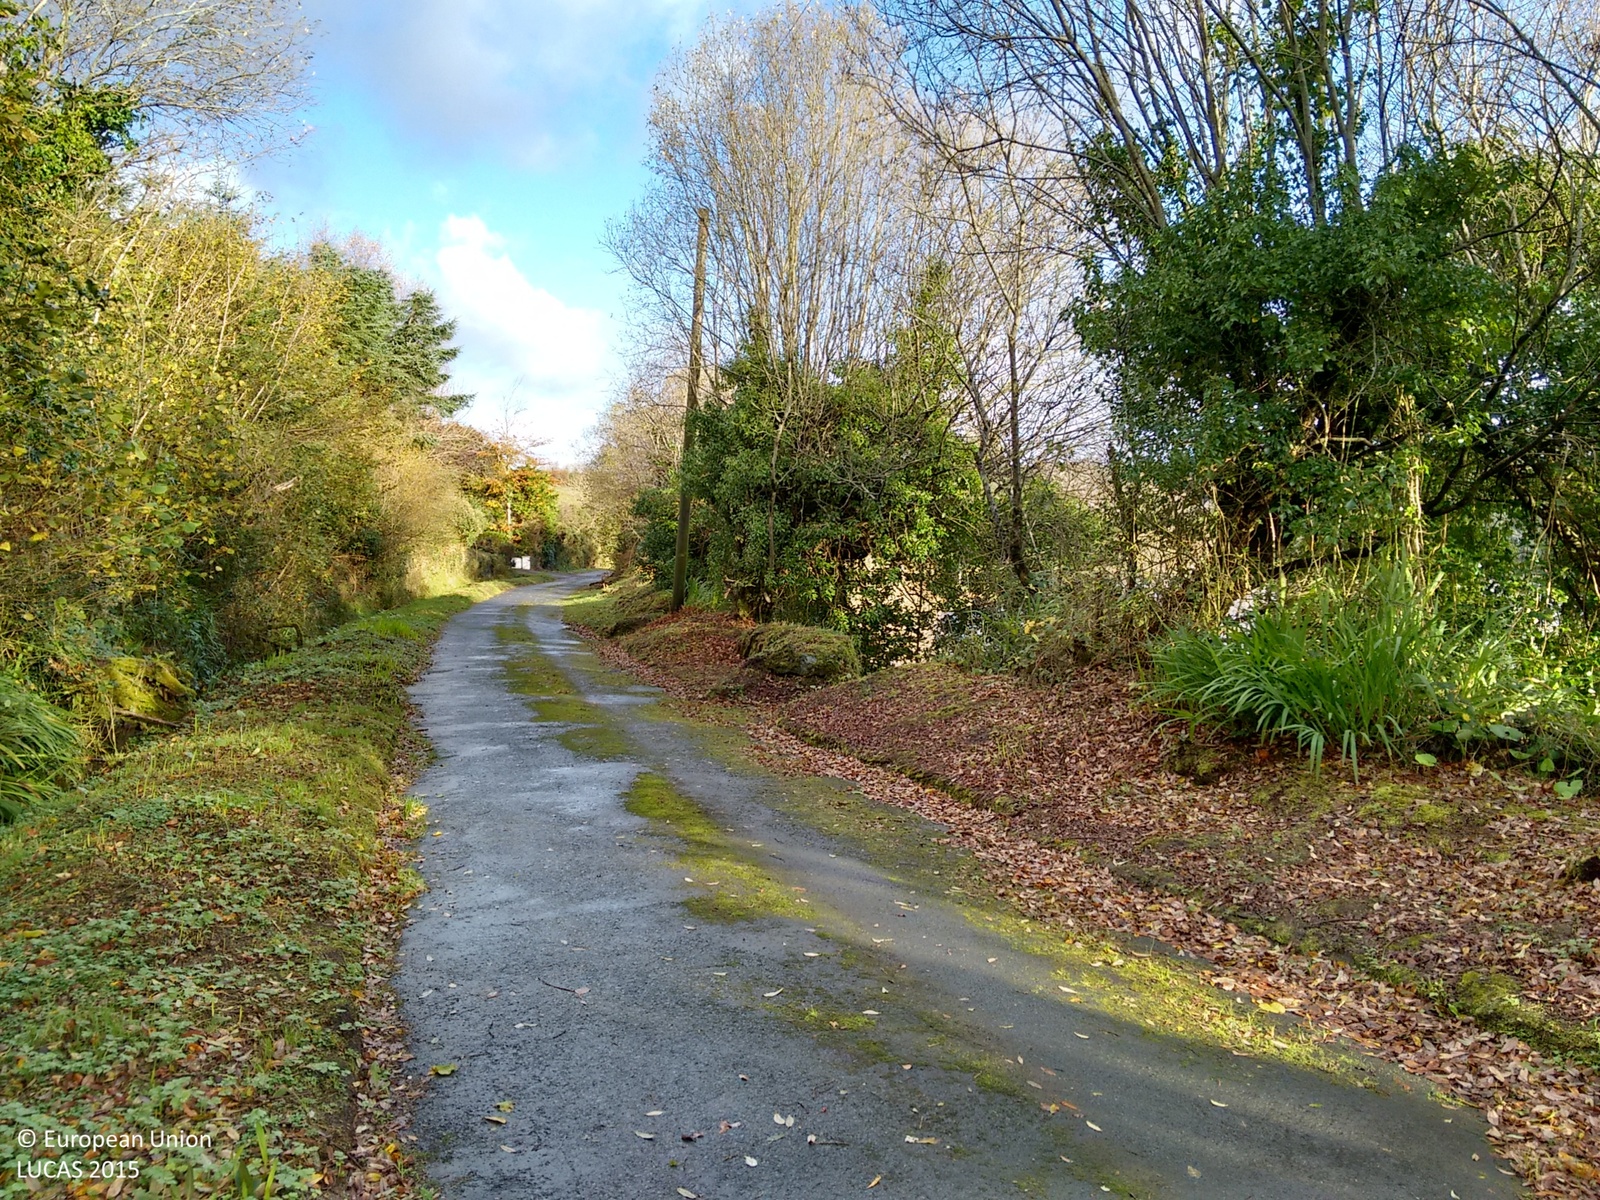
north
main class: Woodland
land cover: Broadleaved woodland
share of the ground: > 75 %
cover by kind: broadleaved forest trees 80 %, herbaceous plants 20 %
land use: Semi-natural and natural areas not in use
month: November
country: IE
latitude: 54.6493
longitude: -8.4292
